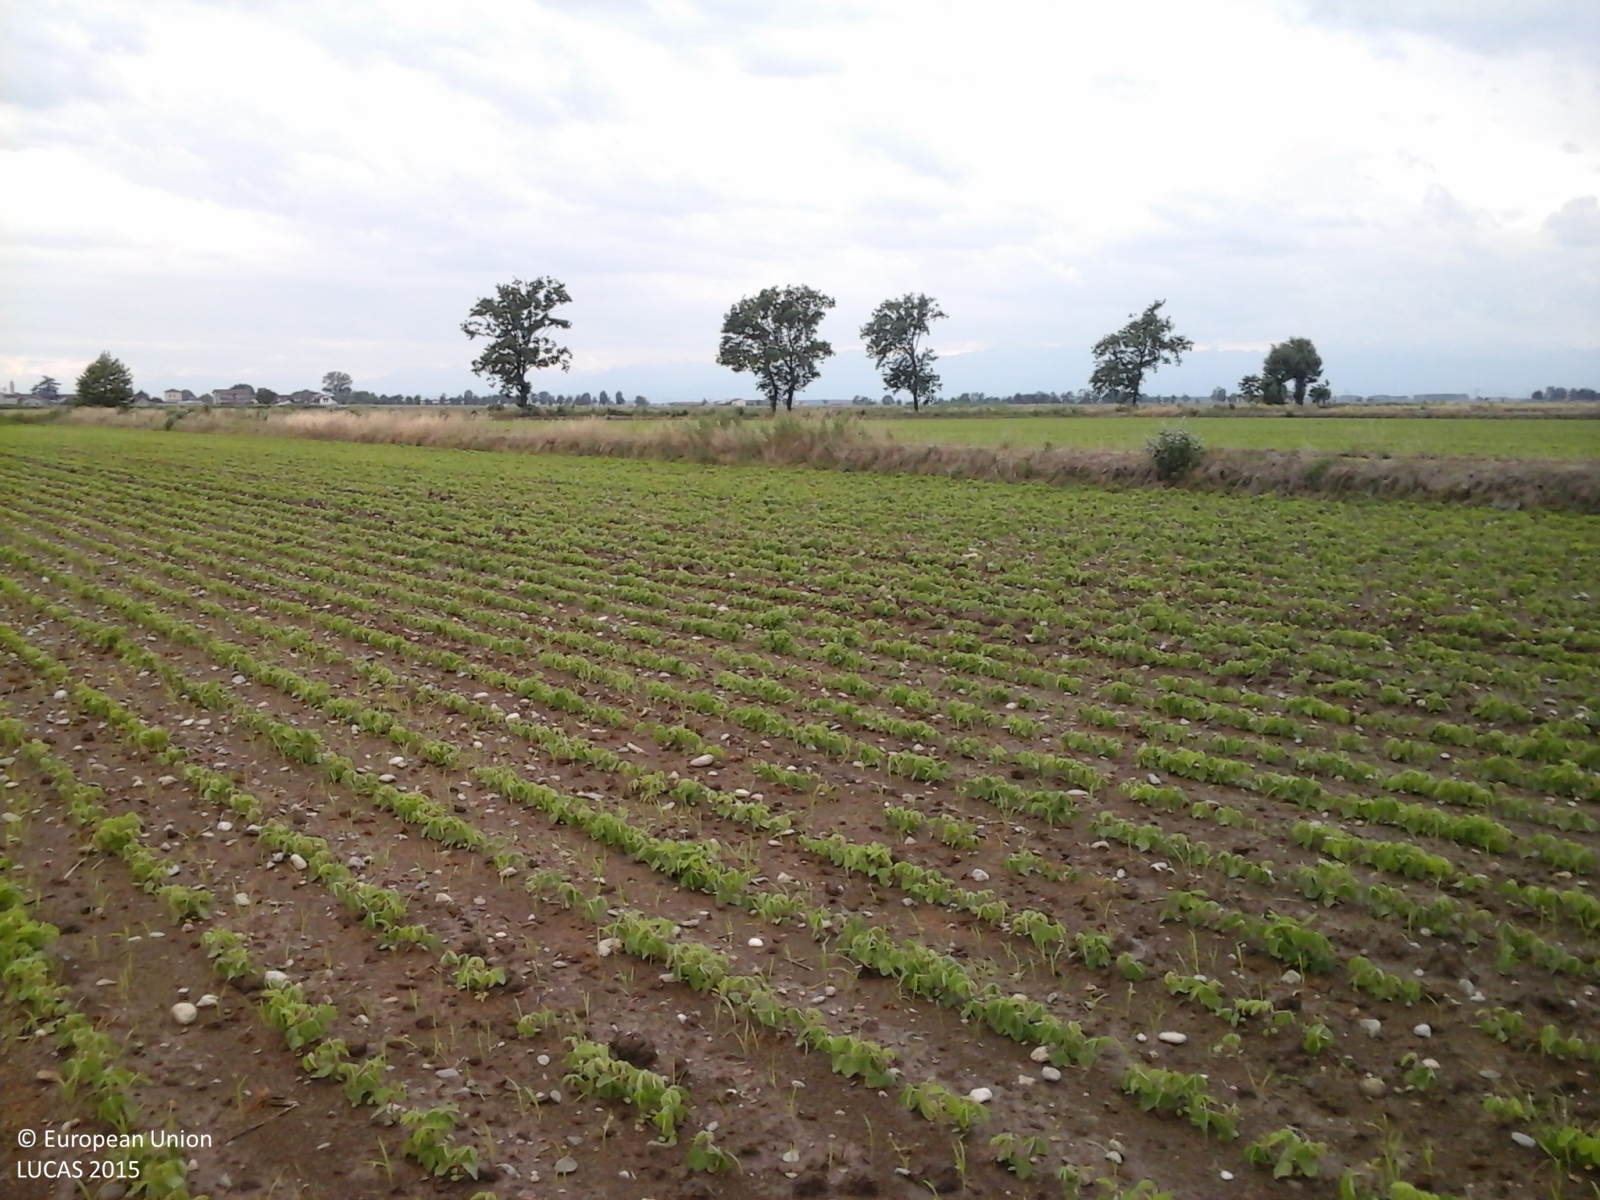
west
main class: Cropland
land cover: Soya
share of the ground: 10 - 25 %
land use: Agriculture (excluding fallow land and kitchen gardens)
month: May
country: IT
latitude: 45.4405
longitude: 8.5578
